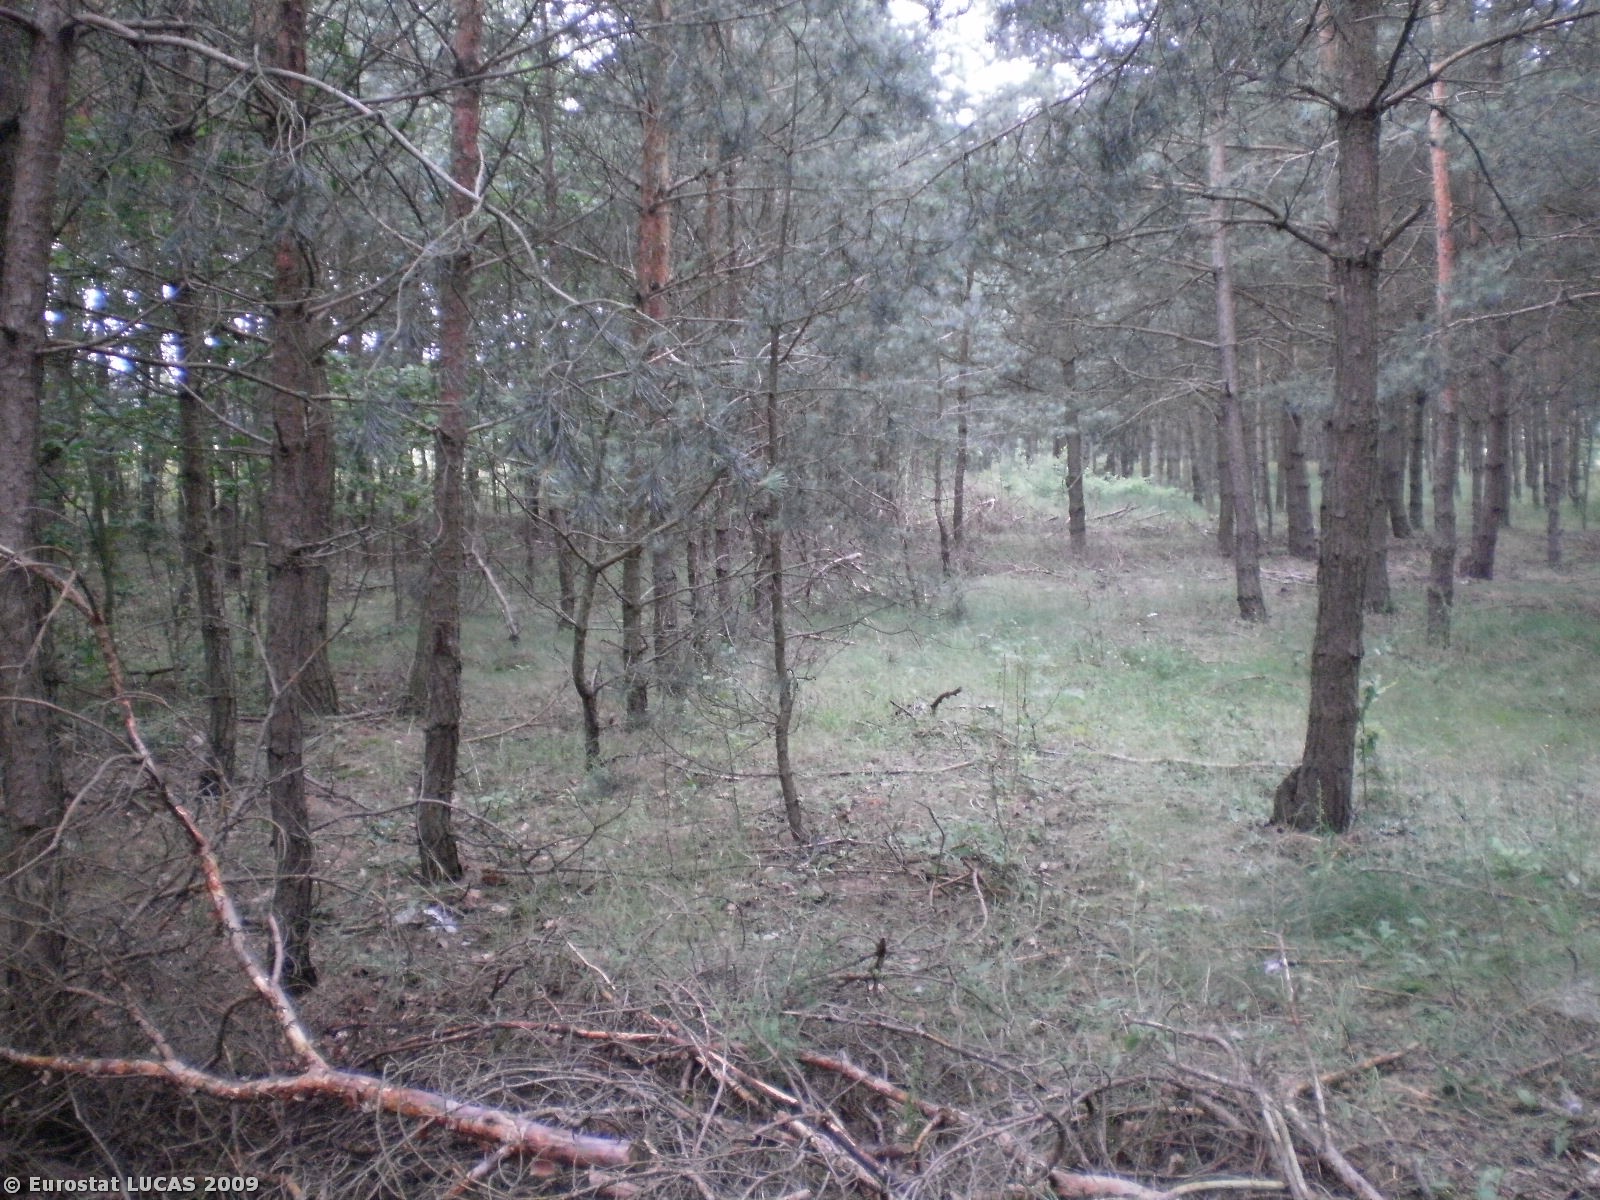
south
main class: Woodland
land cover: Coniferous woodland
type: hemiboreal forest and nemoral coniferous forest and mixed broadleaved-coniferous forest
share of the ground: > 75 %
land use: Forestry
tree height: > 5 m
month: July
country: PL
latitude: 52.7680
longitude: 20.8467
